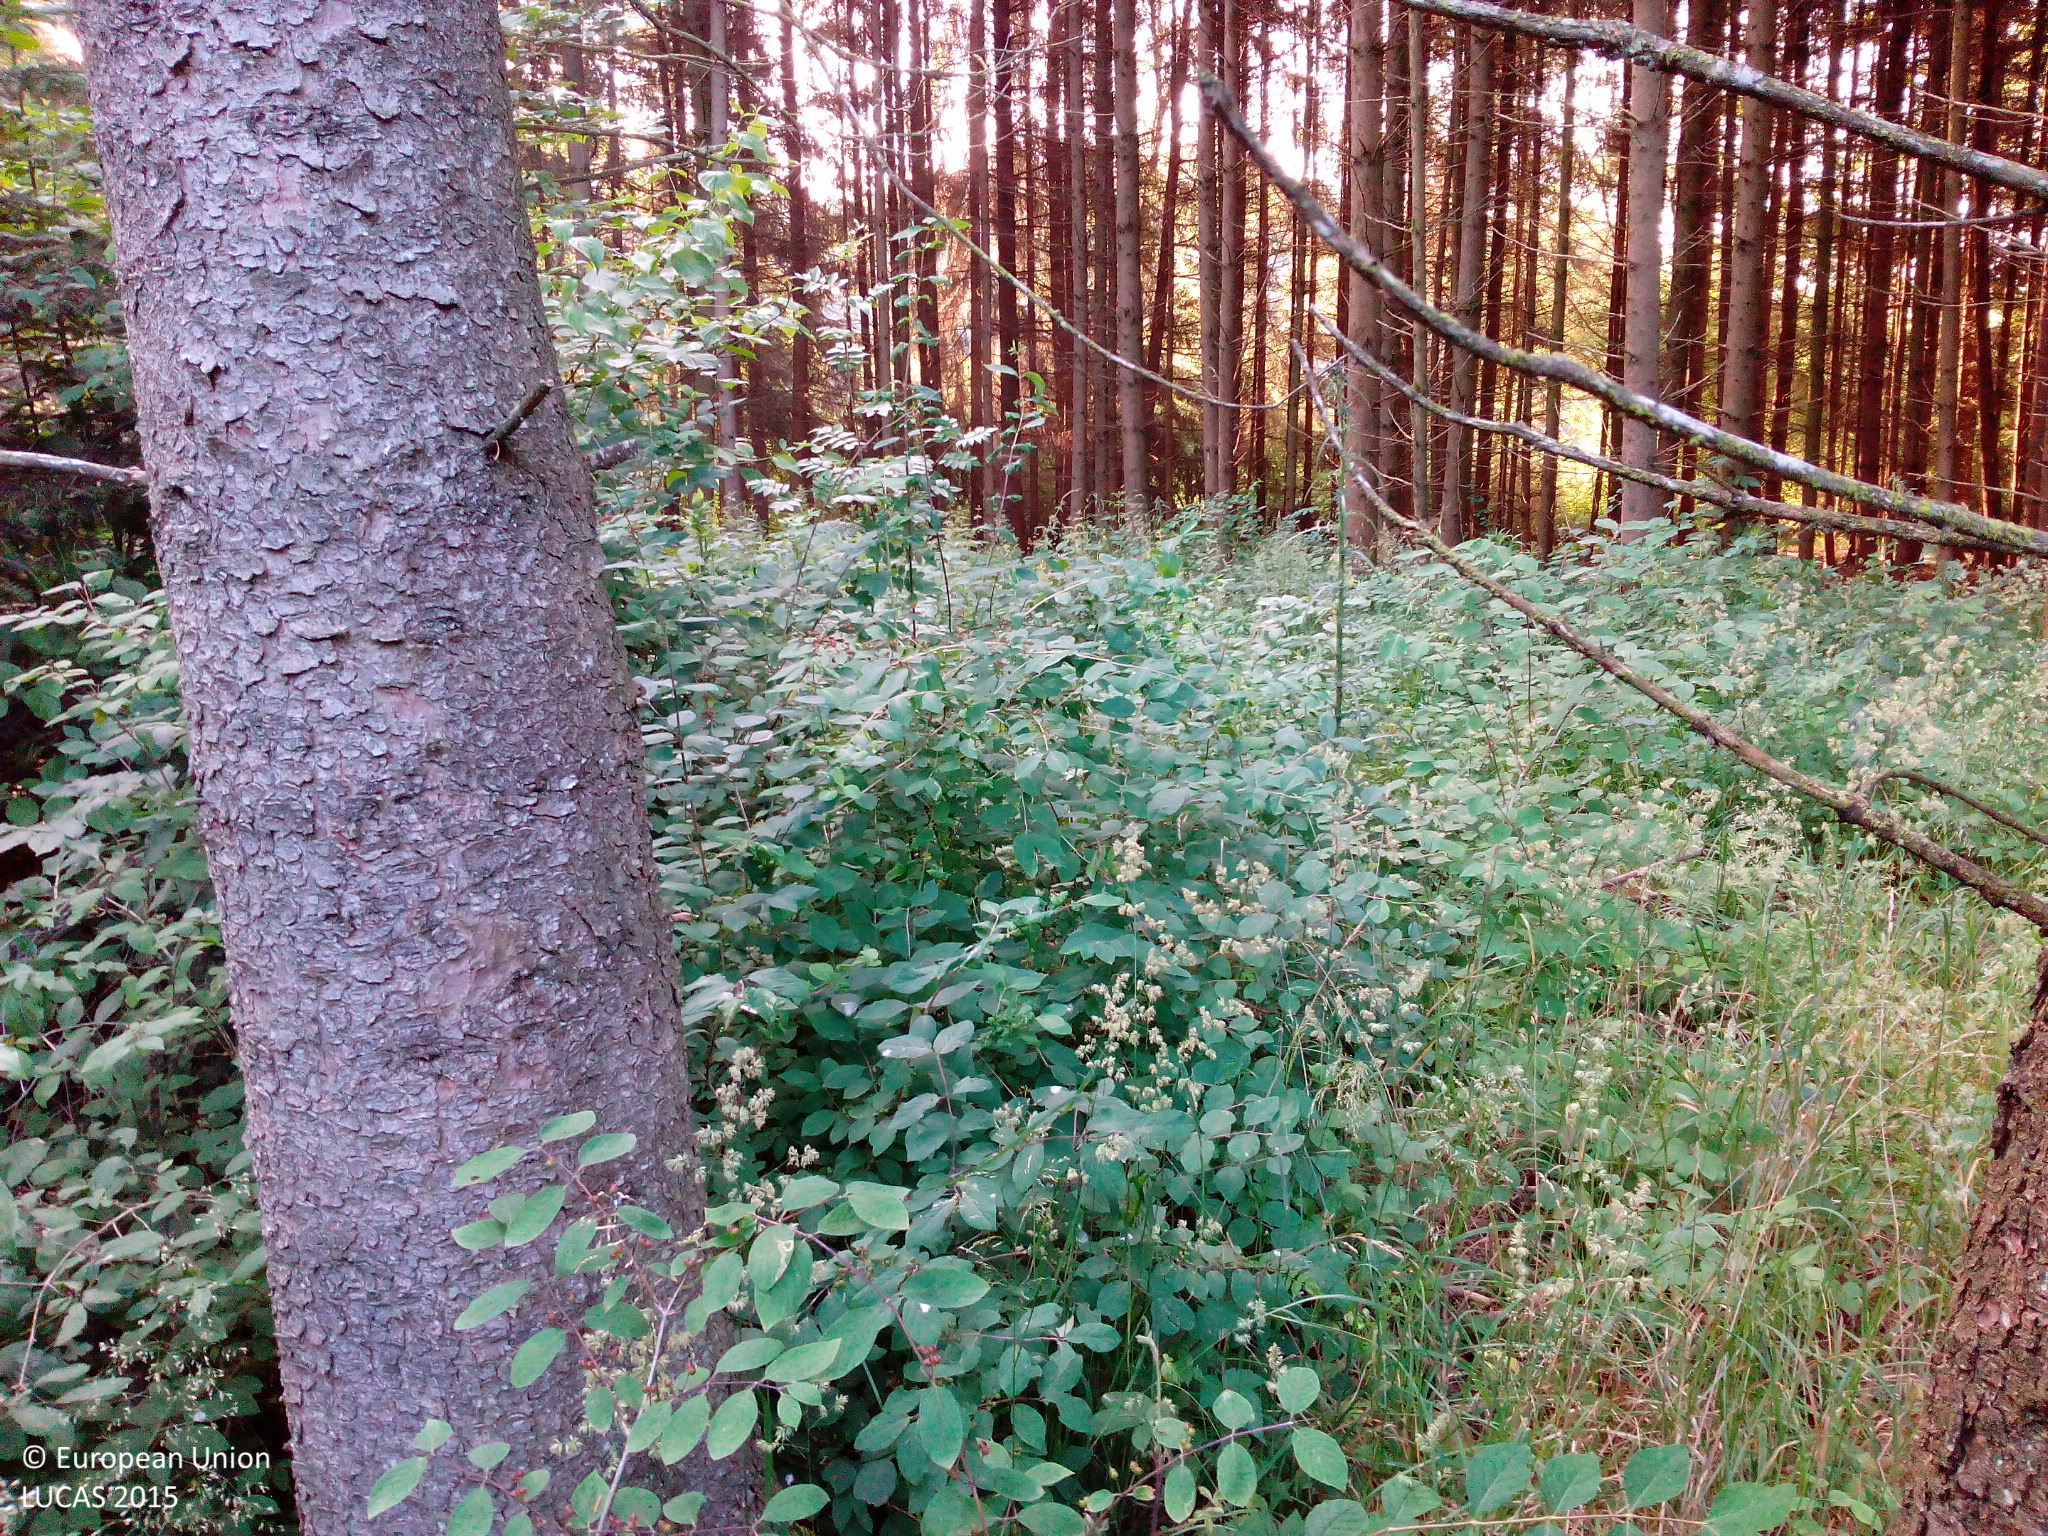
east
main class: Woodland
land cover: Spruce dominated coniferous woodland
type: hemiboreal forest and nemoral coniferous forest and mixed broadleaved-coniferous forest
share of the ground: > 75 %
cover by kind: coniferous forest trees 85 %, shrubs 15 %
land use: Forestry
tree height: > 5 m
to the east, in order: Spruce dominated coniferous woodland; Fences; Spruce dominated coniferous woodland; Ditches and canals; Managed hedges; Maize; Broadleaved woodland; Paved roads, cycling and walking lanes; Ditches and canals; Shruby margins; Grassland without tree/shrub cover; Spruce dominated mixed woodland; Tracks; Broadleaved woodland; Shrubland with sparse tree cover; Paved roads, cycling and walking lanes
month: July
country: DE
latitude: 48.9037
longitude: 10.8864
